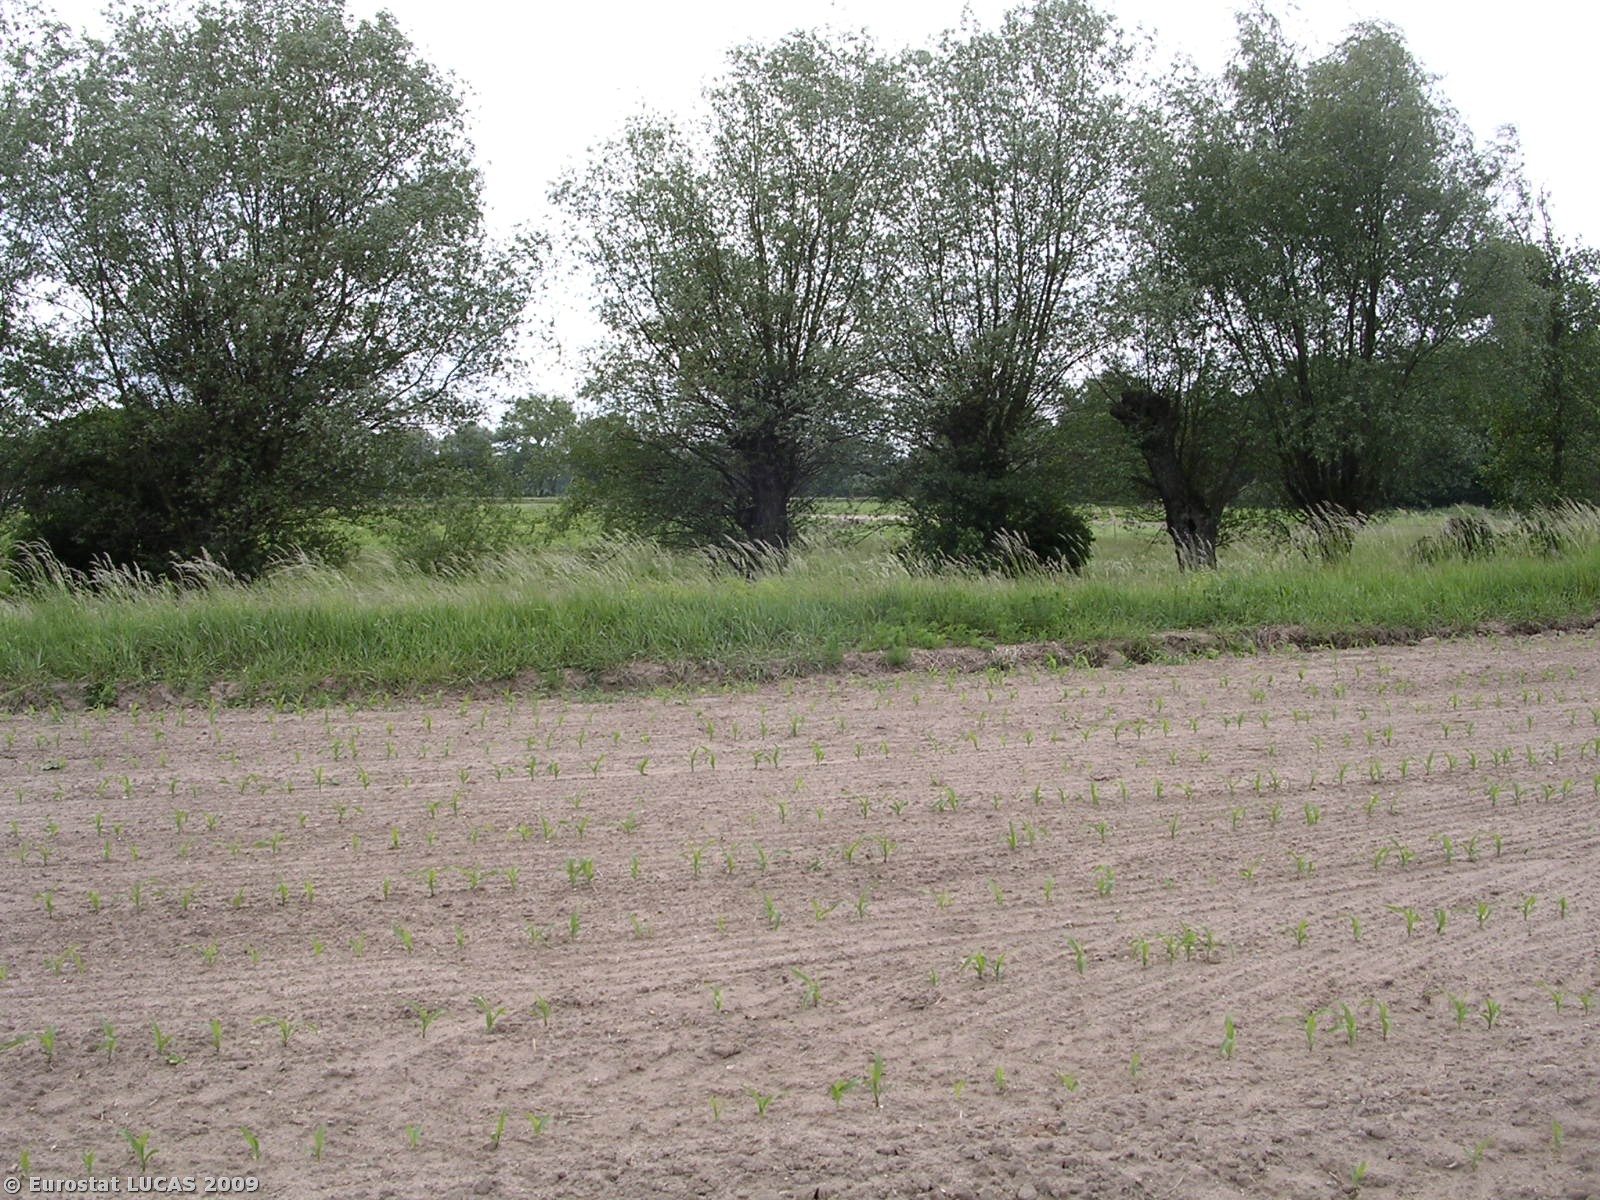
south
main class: Cropland
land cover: Maize
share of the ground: < 10 %
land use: Agriculture (excluding fallow land and kitchen gardens)
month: May
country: CZ
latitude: 50.1863
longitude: 14.9185
